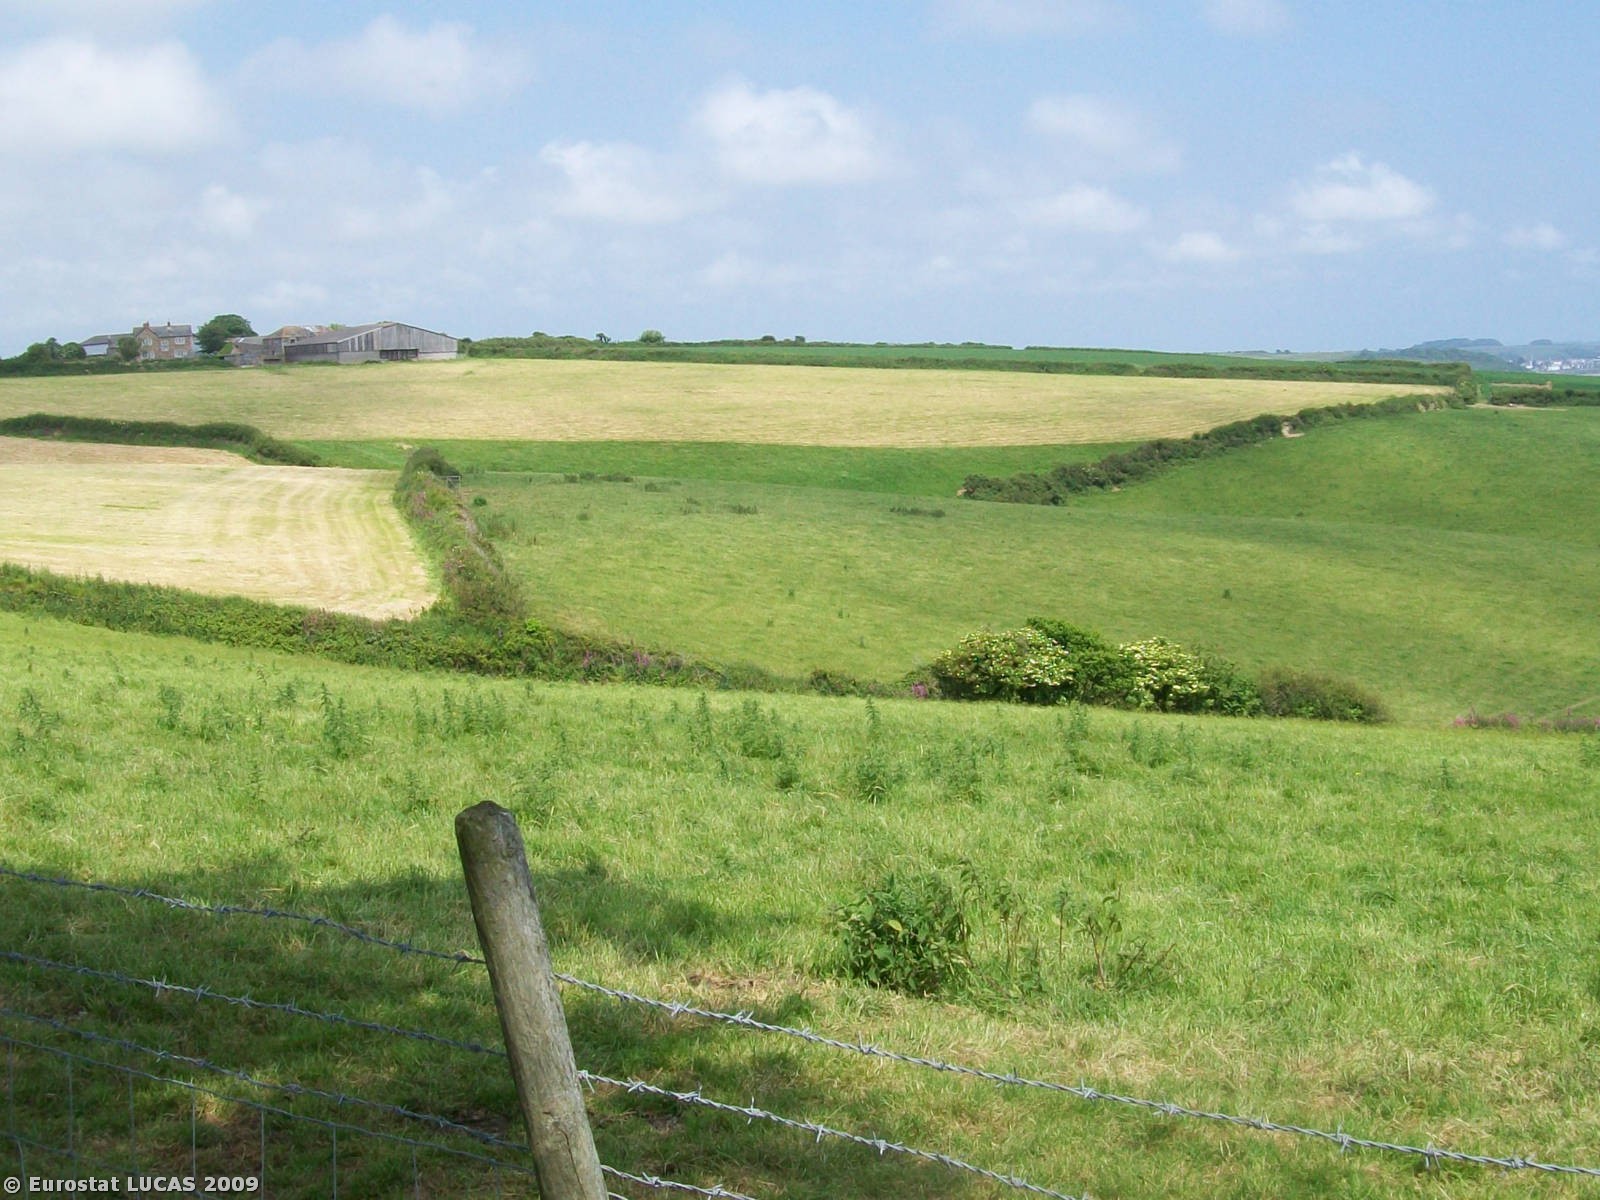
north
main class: Grassland
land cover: Grassland without tree/shrub cover
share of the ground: > 75 %
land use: Agriculture (excluding fallow land and kitchen gardens)
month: June
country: GB
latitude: 50.1052
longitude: -5.0919
